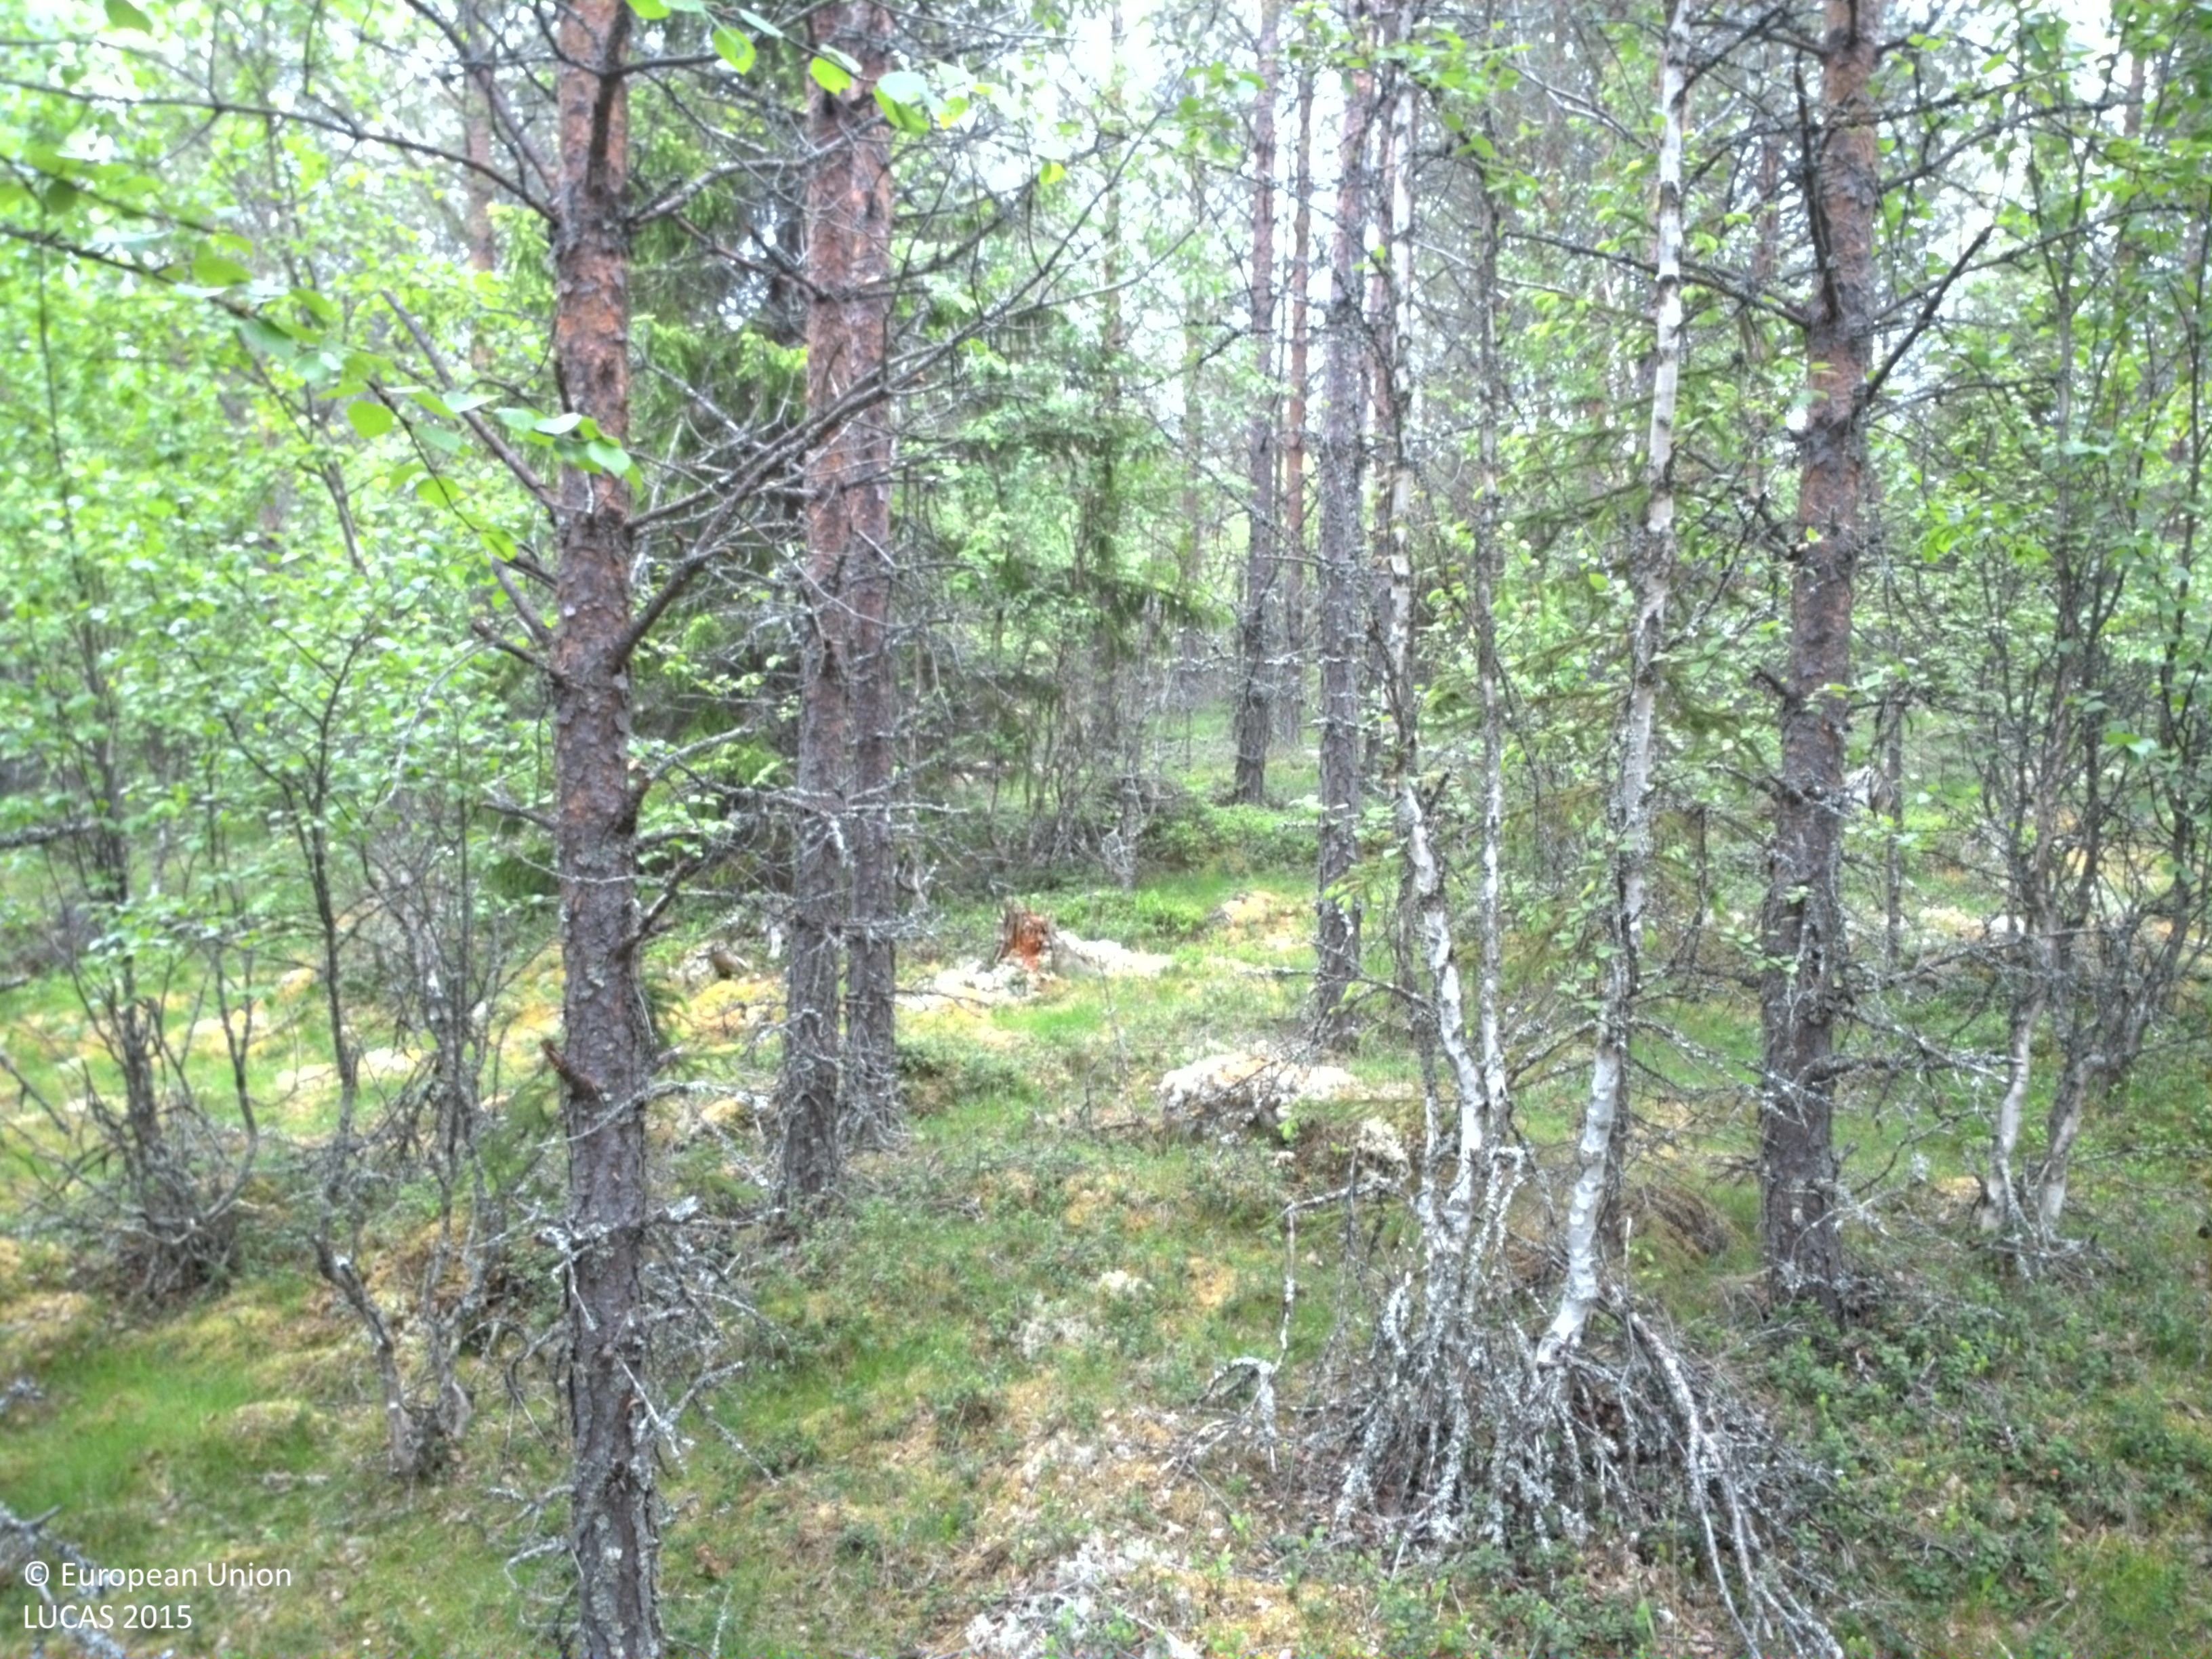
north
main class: Woodland
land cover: Pine dominated mixed woodland
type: boreal forest
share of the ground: 50 - 75 %
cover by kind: coniferous forest trees 50 %, broadleaved forest trees 25 %, lichens and mosses 15 %, herbaceous plants 10 %
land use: Forestry
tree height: > 5 m
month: June
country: SE
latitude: 61.1610
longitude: 13.6490
